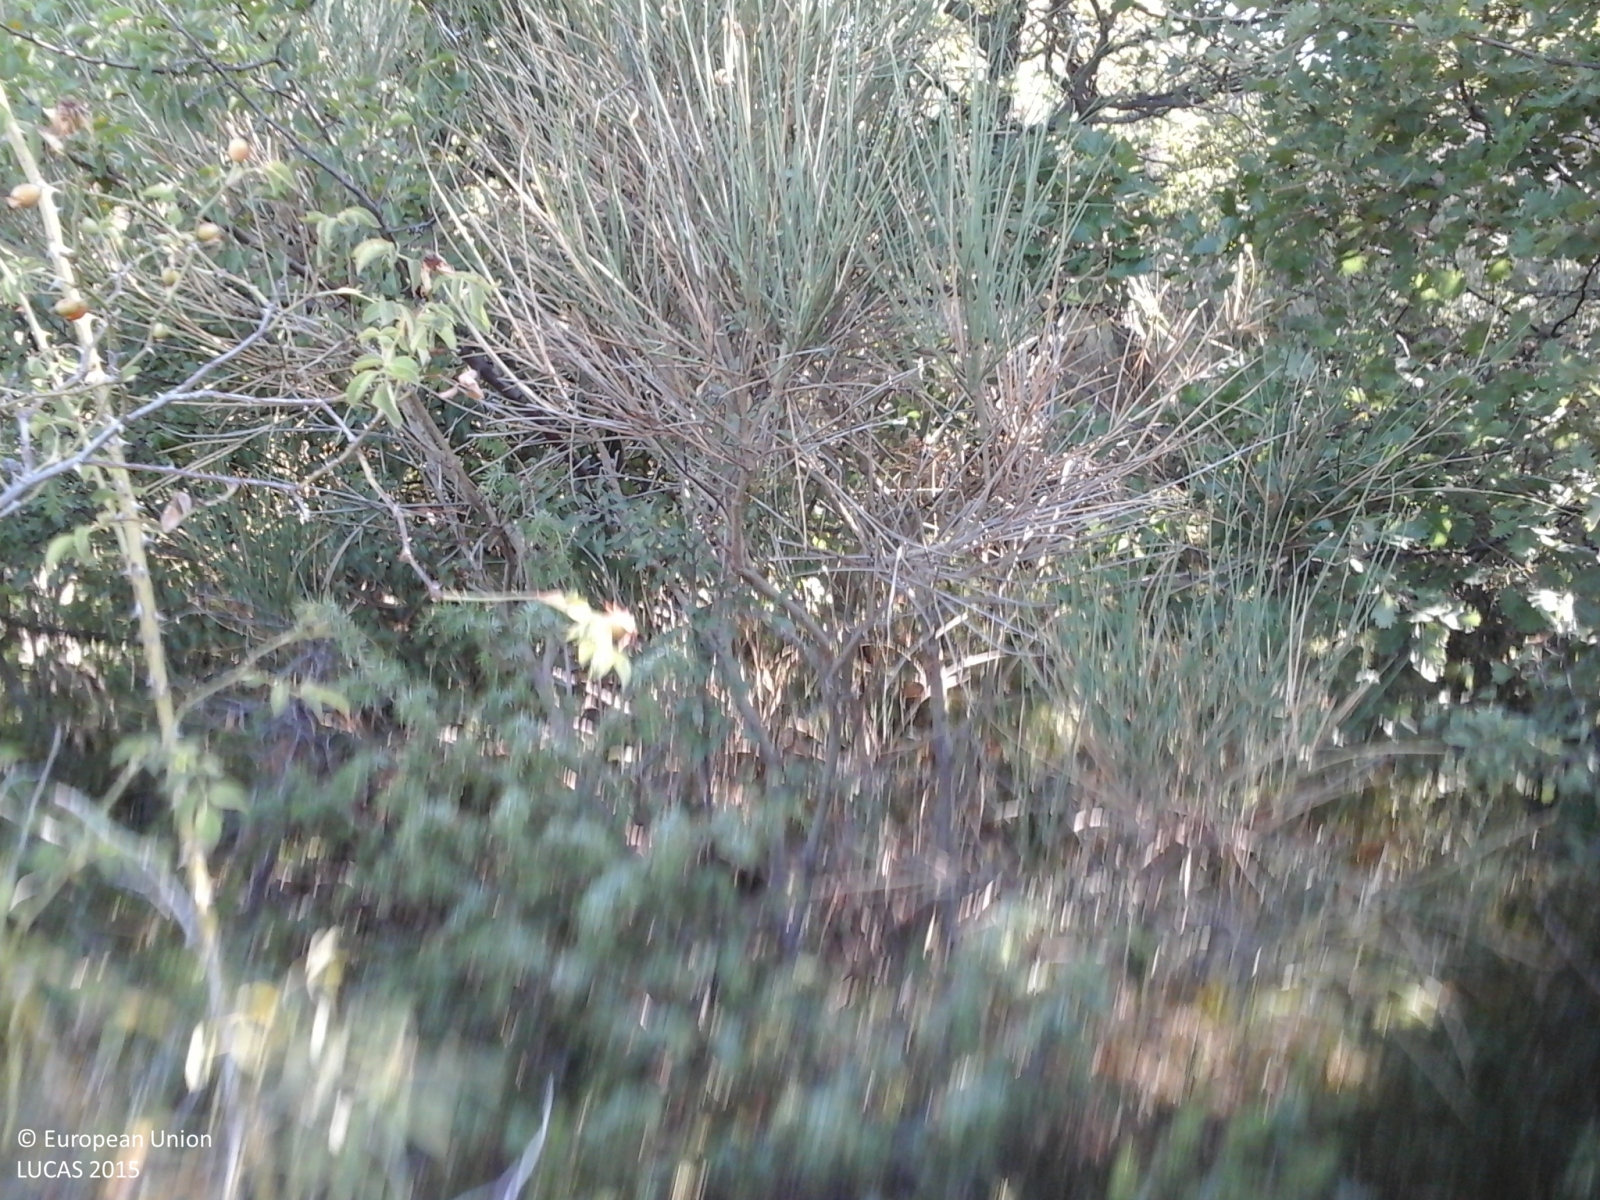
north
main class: Woodland
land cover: Broadleaved woodland
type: thermophilous deciduous forest
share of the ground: > 75 %
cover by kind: broadleaved forest trees 70 %, shrubs 20 %, herbaceous plants 10 %
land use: Semi-natural and natural areas not in use
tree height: < 5 m
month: August
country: IT
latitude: 42.9480
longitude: 11.6250
